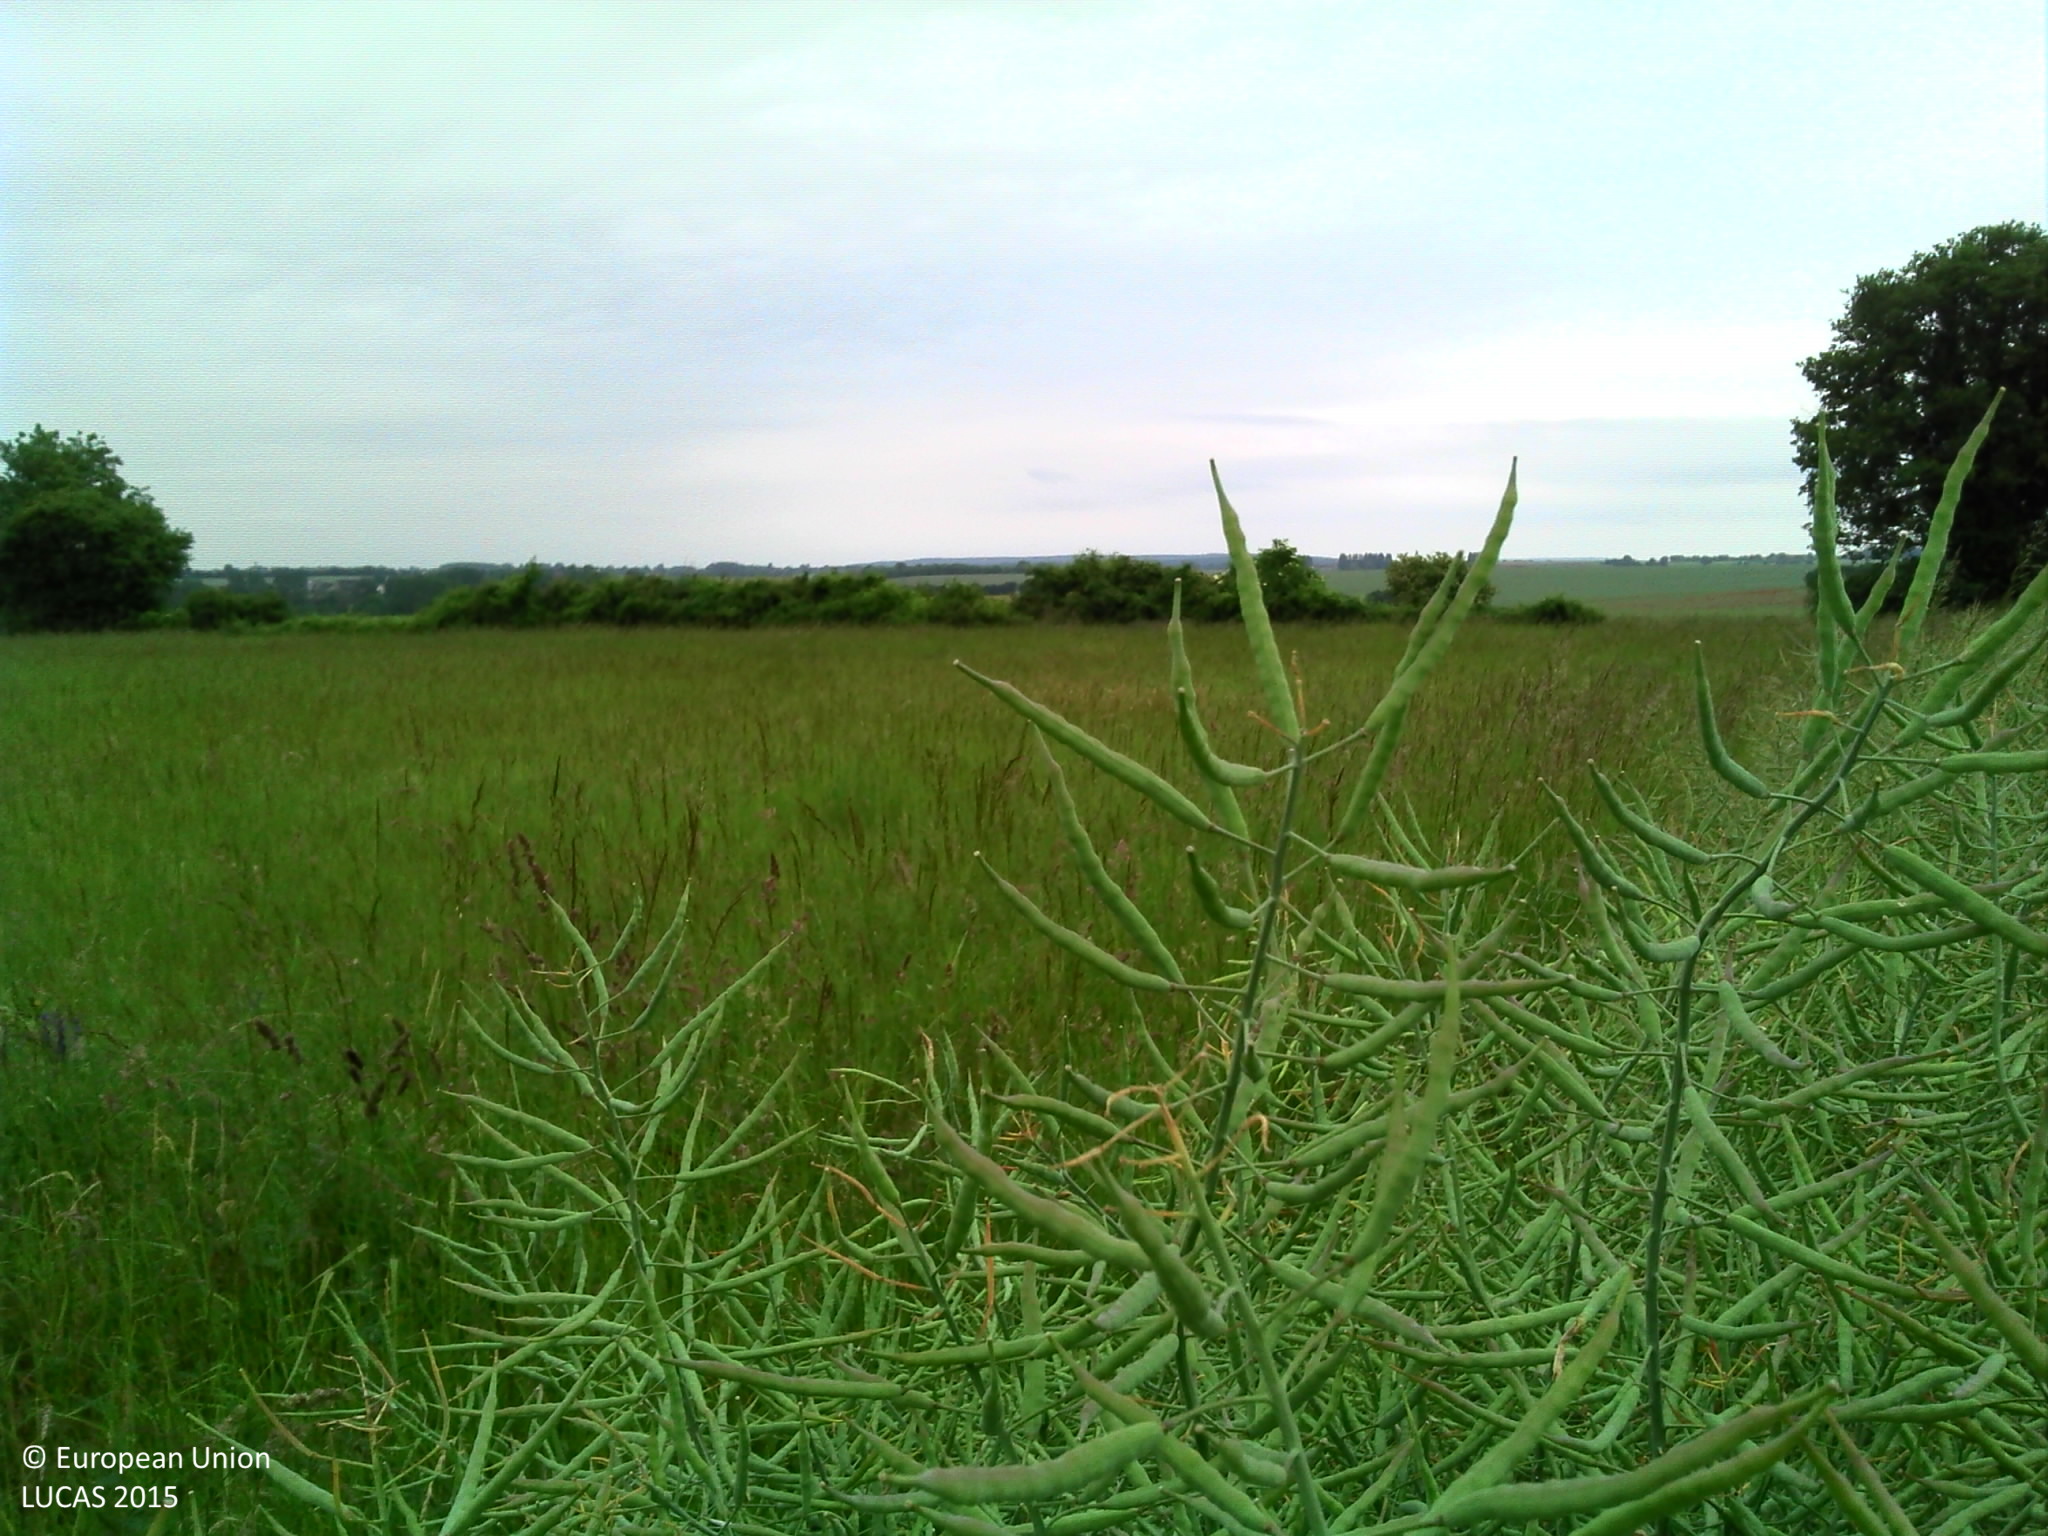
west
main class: Cropland
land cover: Rape and turnip rape
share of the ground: > 75 %
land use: Agriculture (excluding fallow land and kitchen gardens)
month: May
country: FR
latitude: 47.1266
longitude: 2.8896
